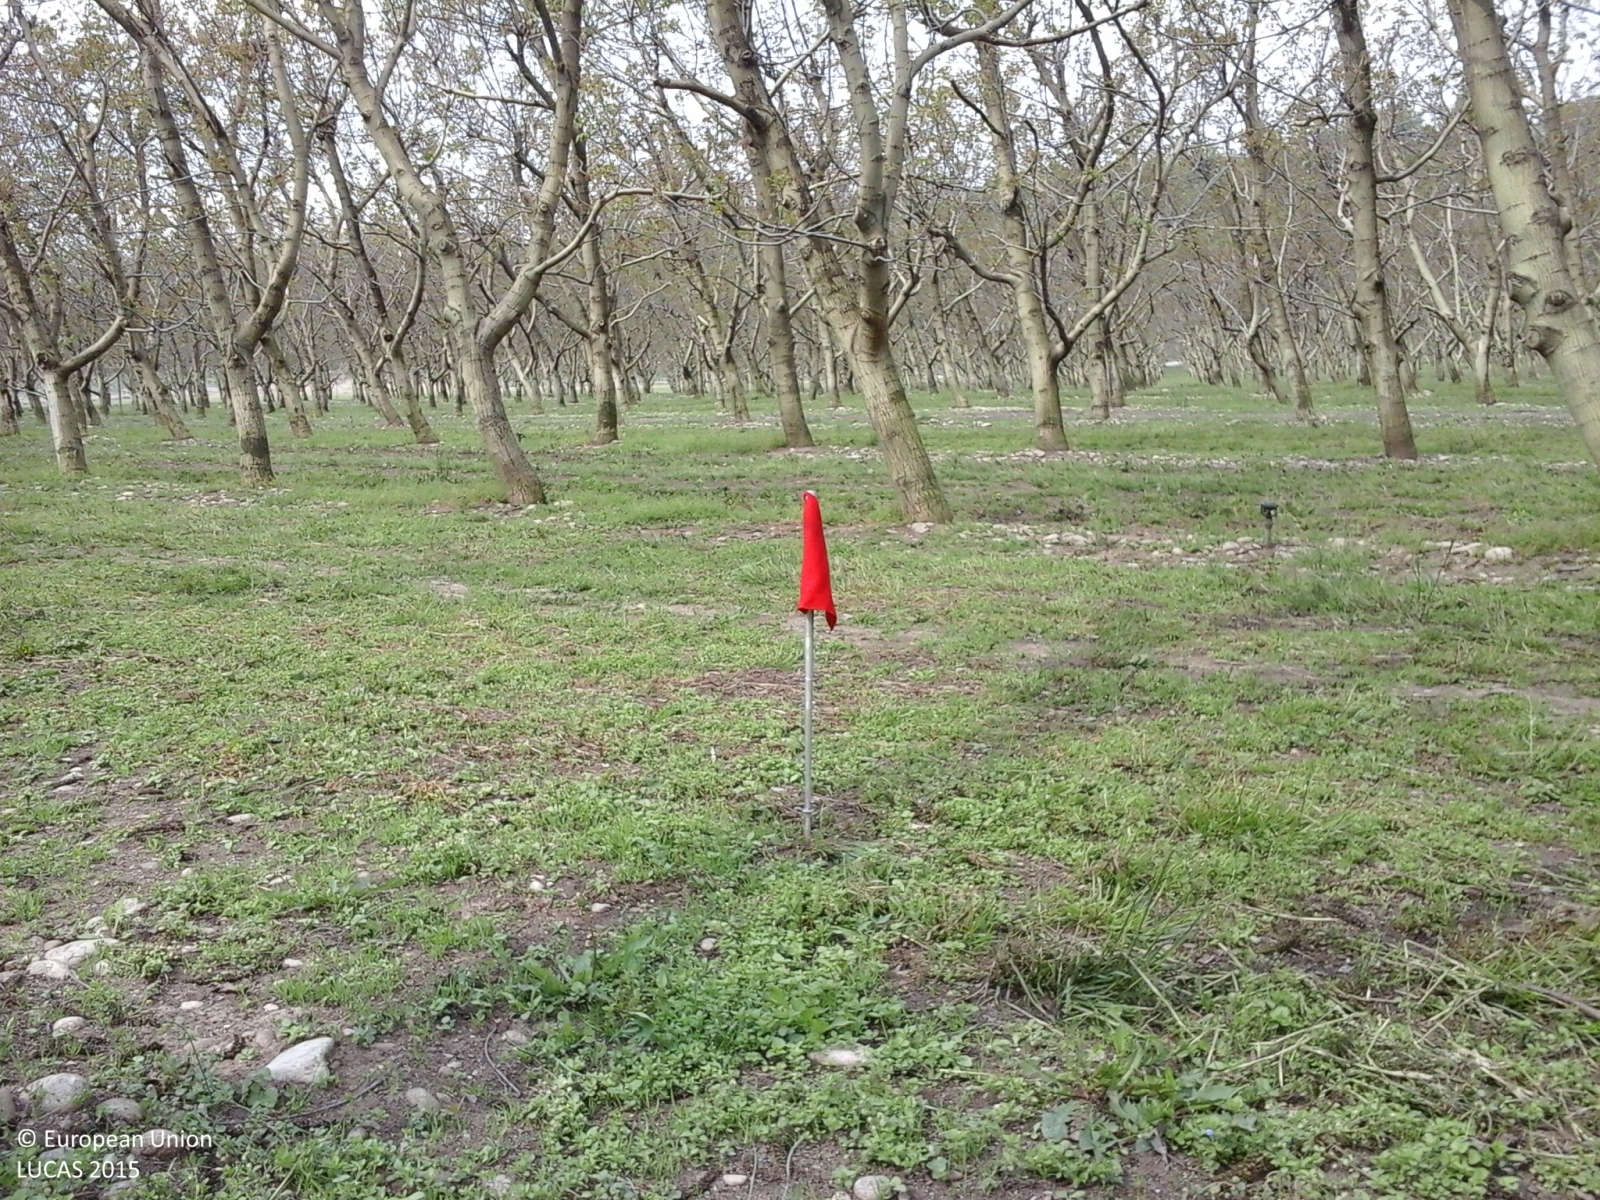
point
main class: Cropland
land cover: Nuts trees
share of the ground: 50 - 75 %
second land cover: Grassland without tree/shrub cover
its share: 50 - 75 %
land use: Agriculture (excluding fallow land and kitchen gardens)
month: May
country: IT
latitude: 44.5973
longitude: 7.7747
